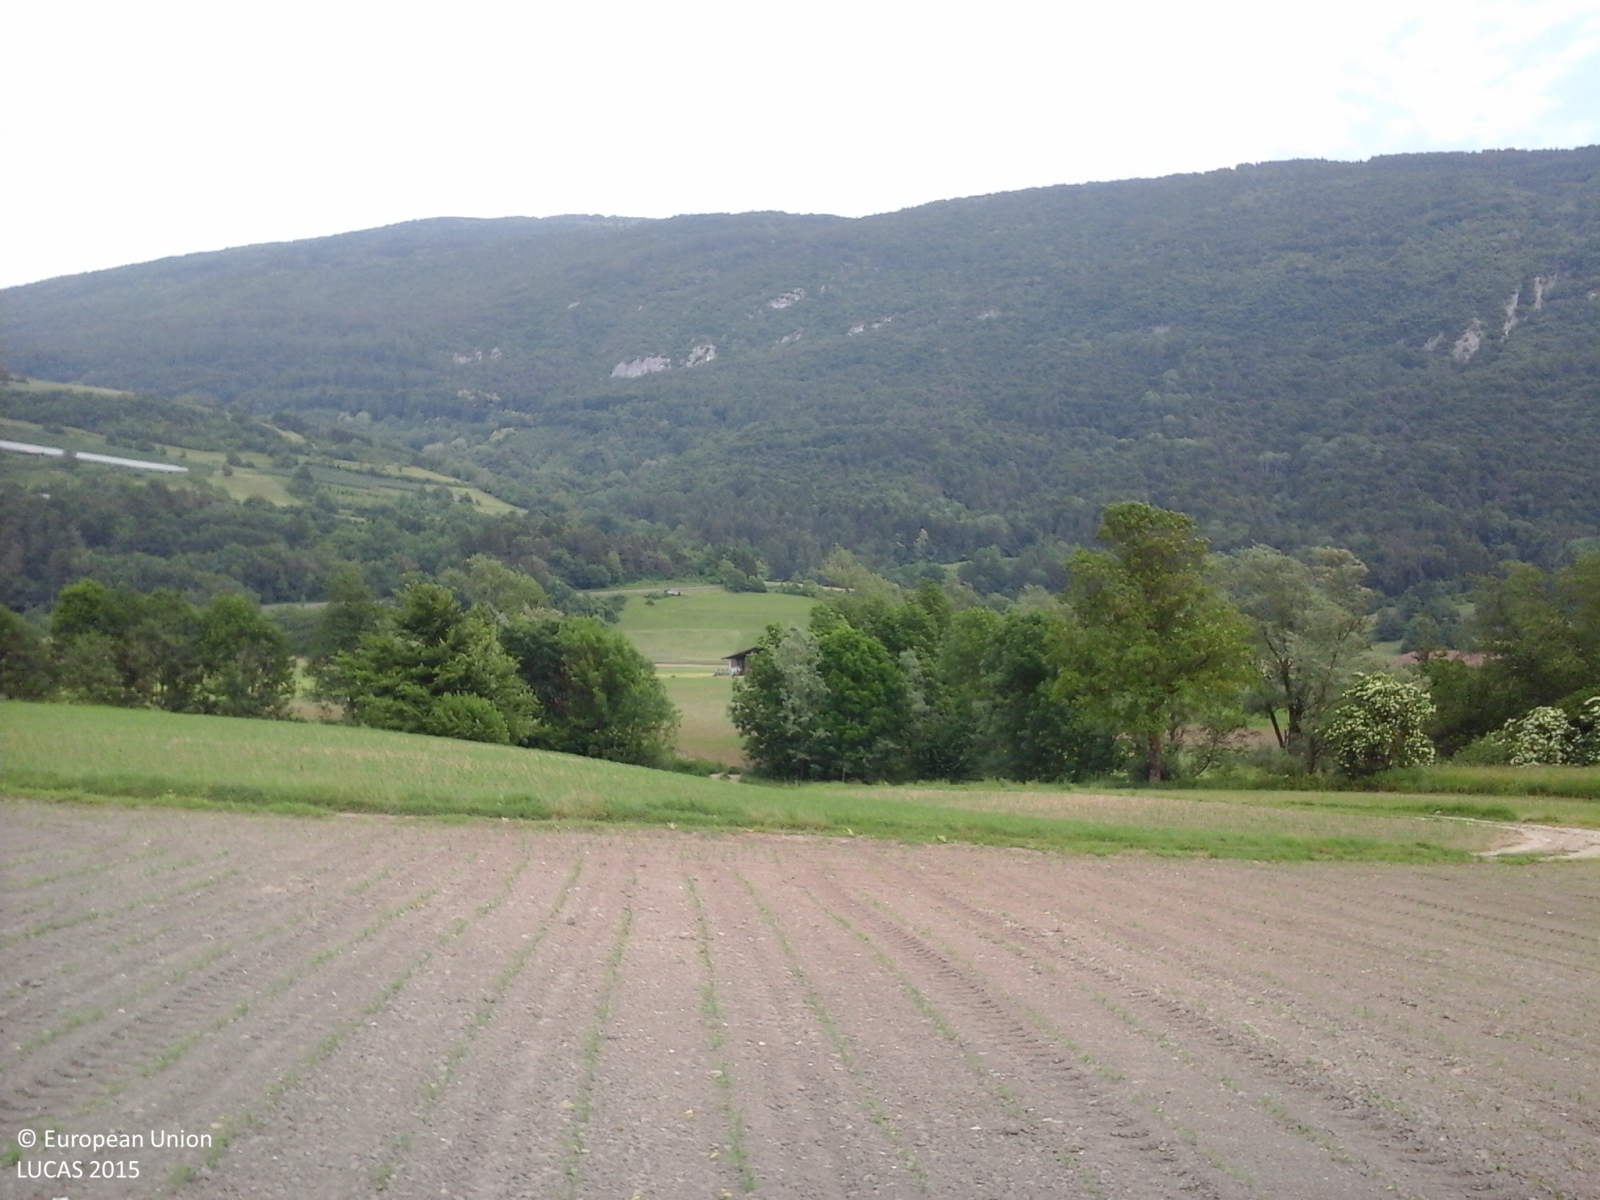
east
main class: Cropland
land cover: Maize
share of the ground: < 10 %
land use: Agriculture (excluding fallow land and kitchen gardens)
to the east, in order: Maize; Grass margins; Tracks; Grass margins; Maize; Grass margins; Broadleaved woodland; Ditches and canals; Spontaneously vegetated surfaces; Maize
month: June
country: IT
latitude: 46.0054
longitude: 10.8640
